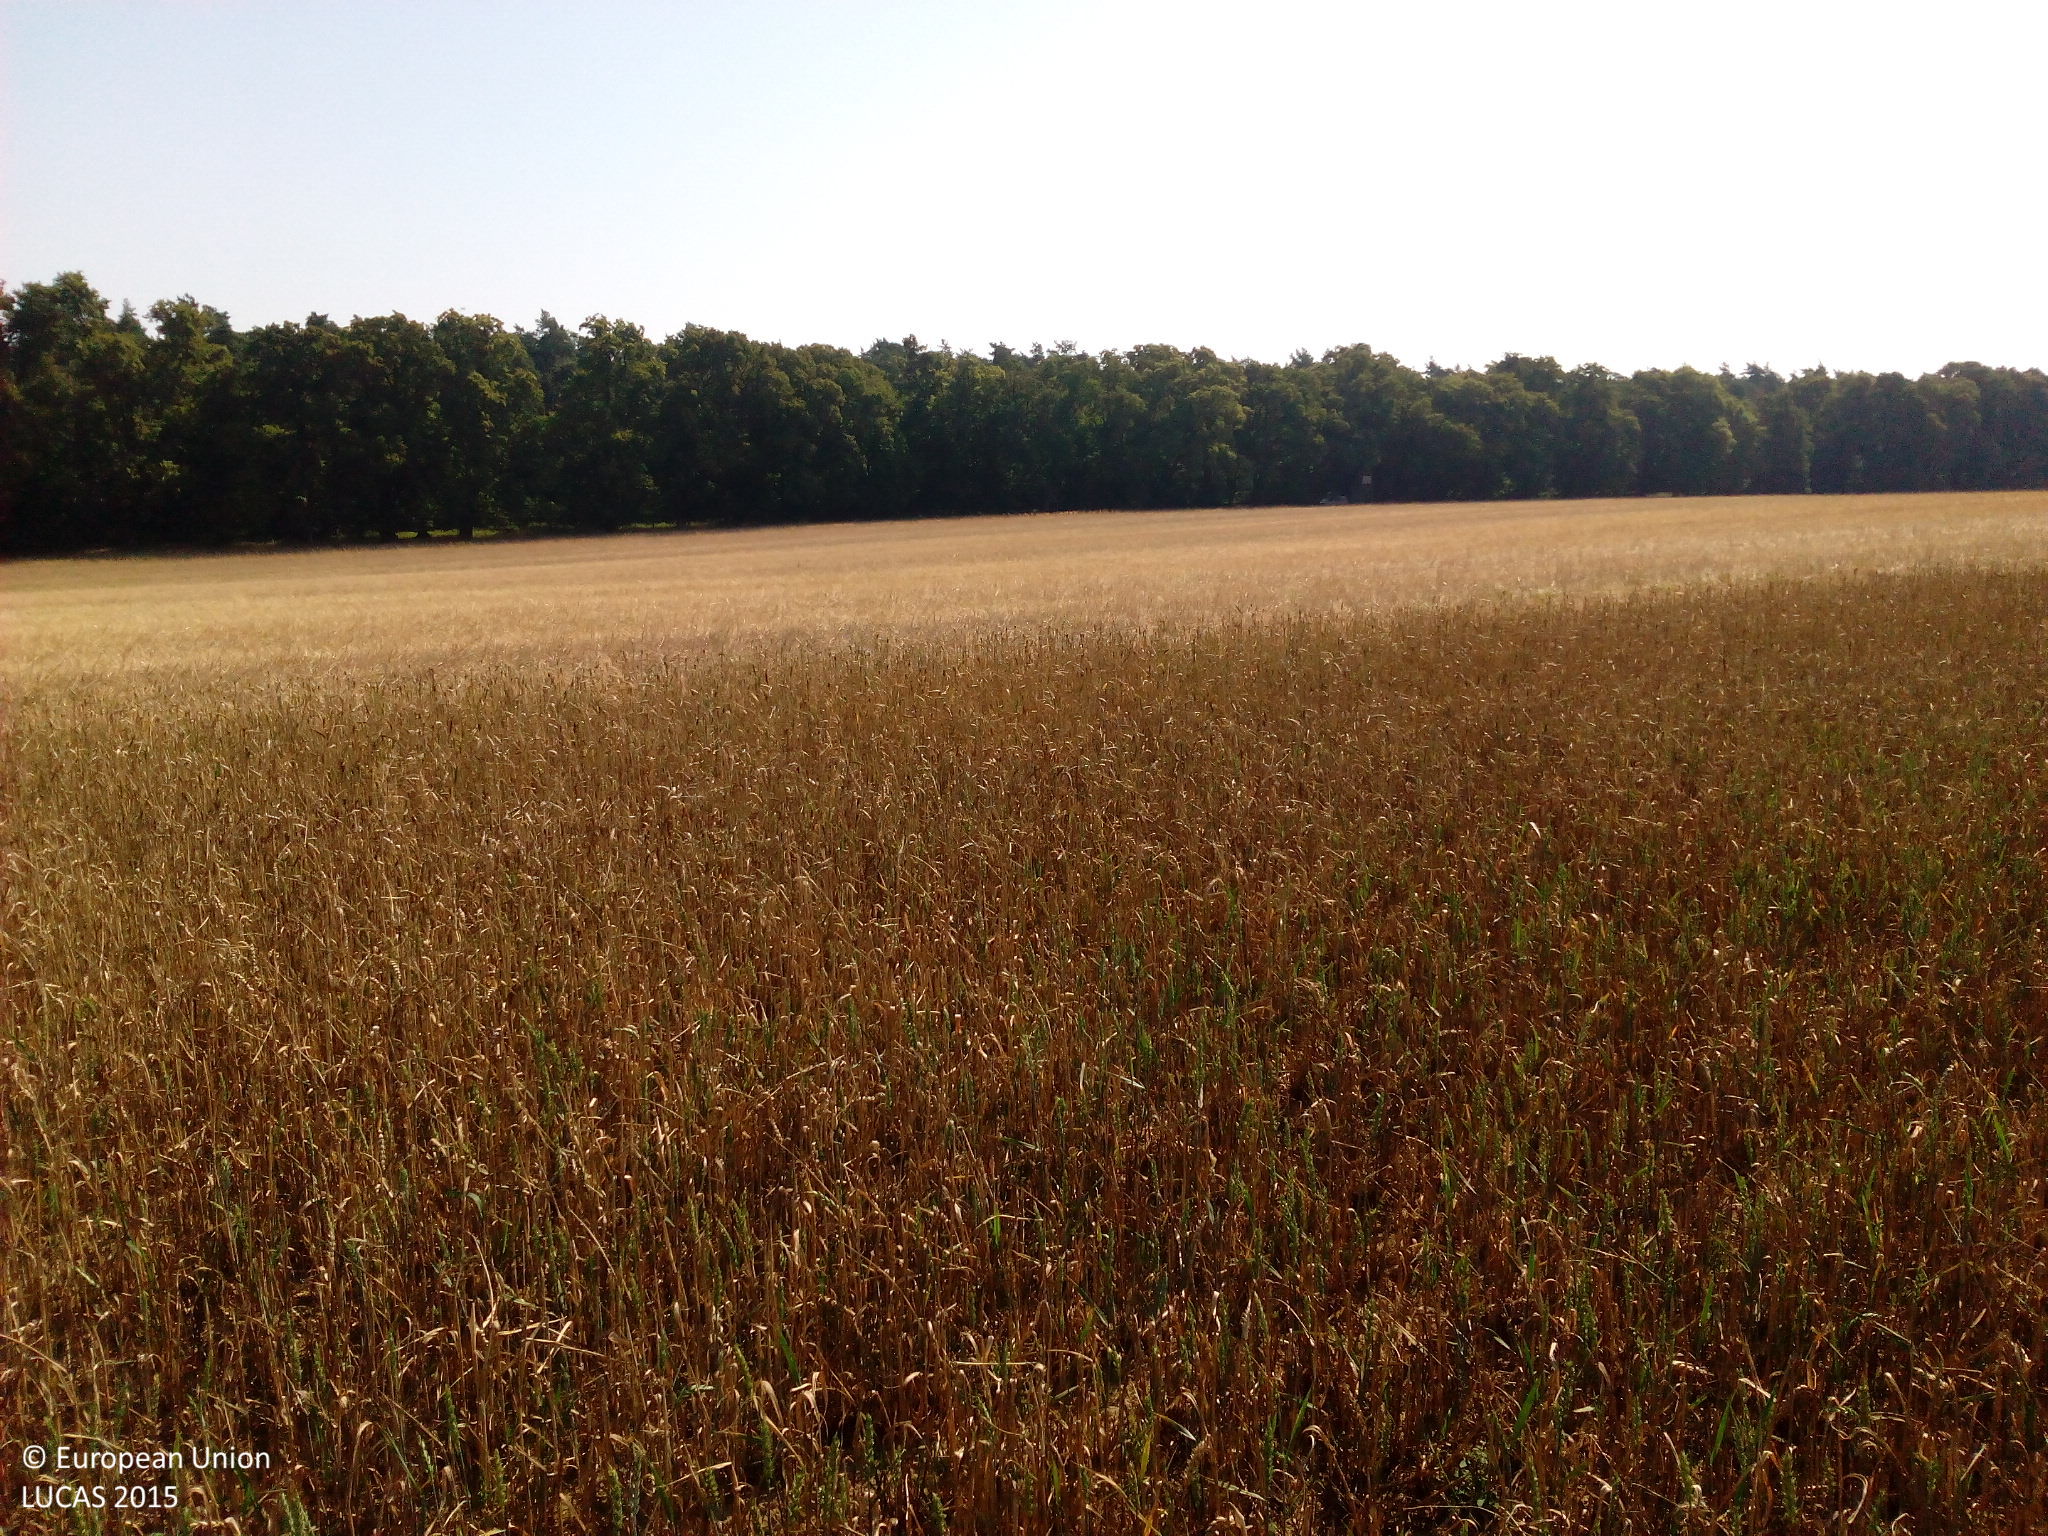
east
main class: Cropland
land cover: Common wheat
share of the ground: 25 - 50 %
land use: Agriculture (excluding fallow land and kitchen gardens)
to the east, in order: Common wheat; Rye; Lines of trees; Tracks; Lines of trees; Pine dominated mixed woodland
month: August
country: DE
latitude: 53.2949
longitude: 13.5857
